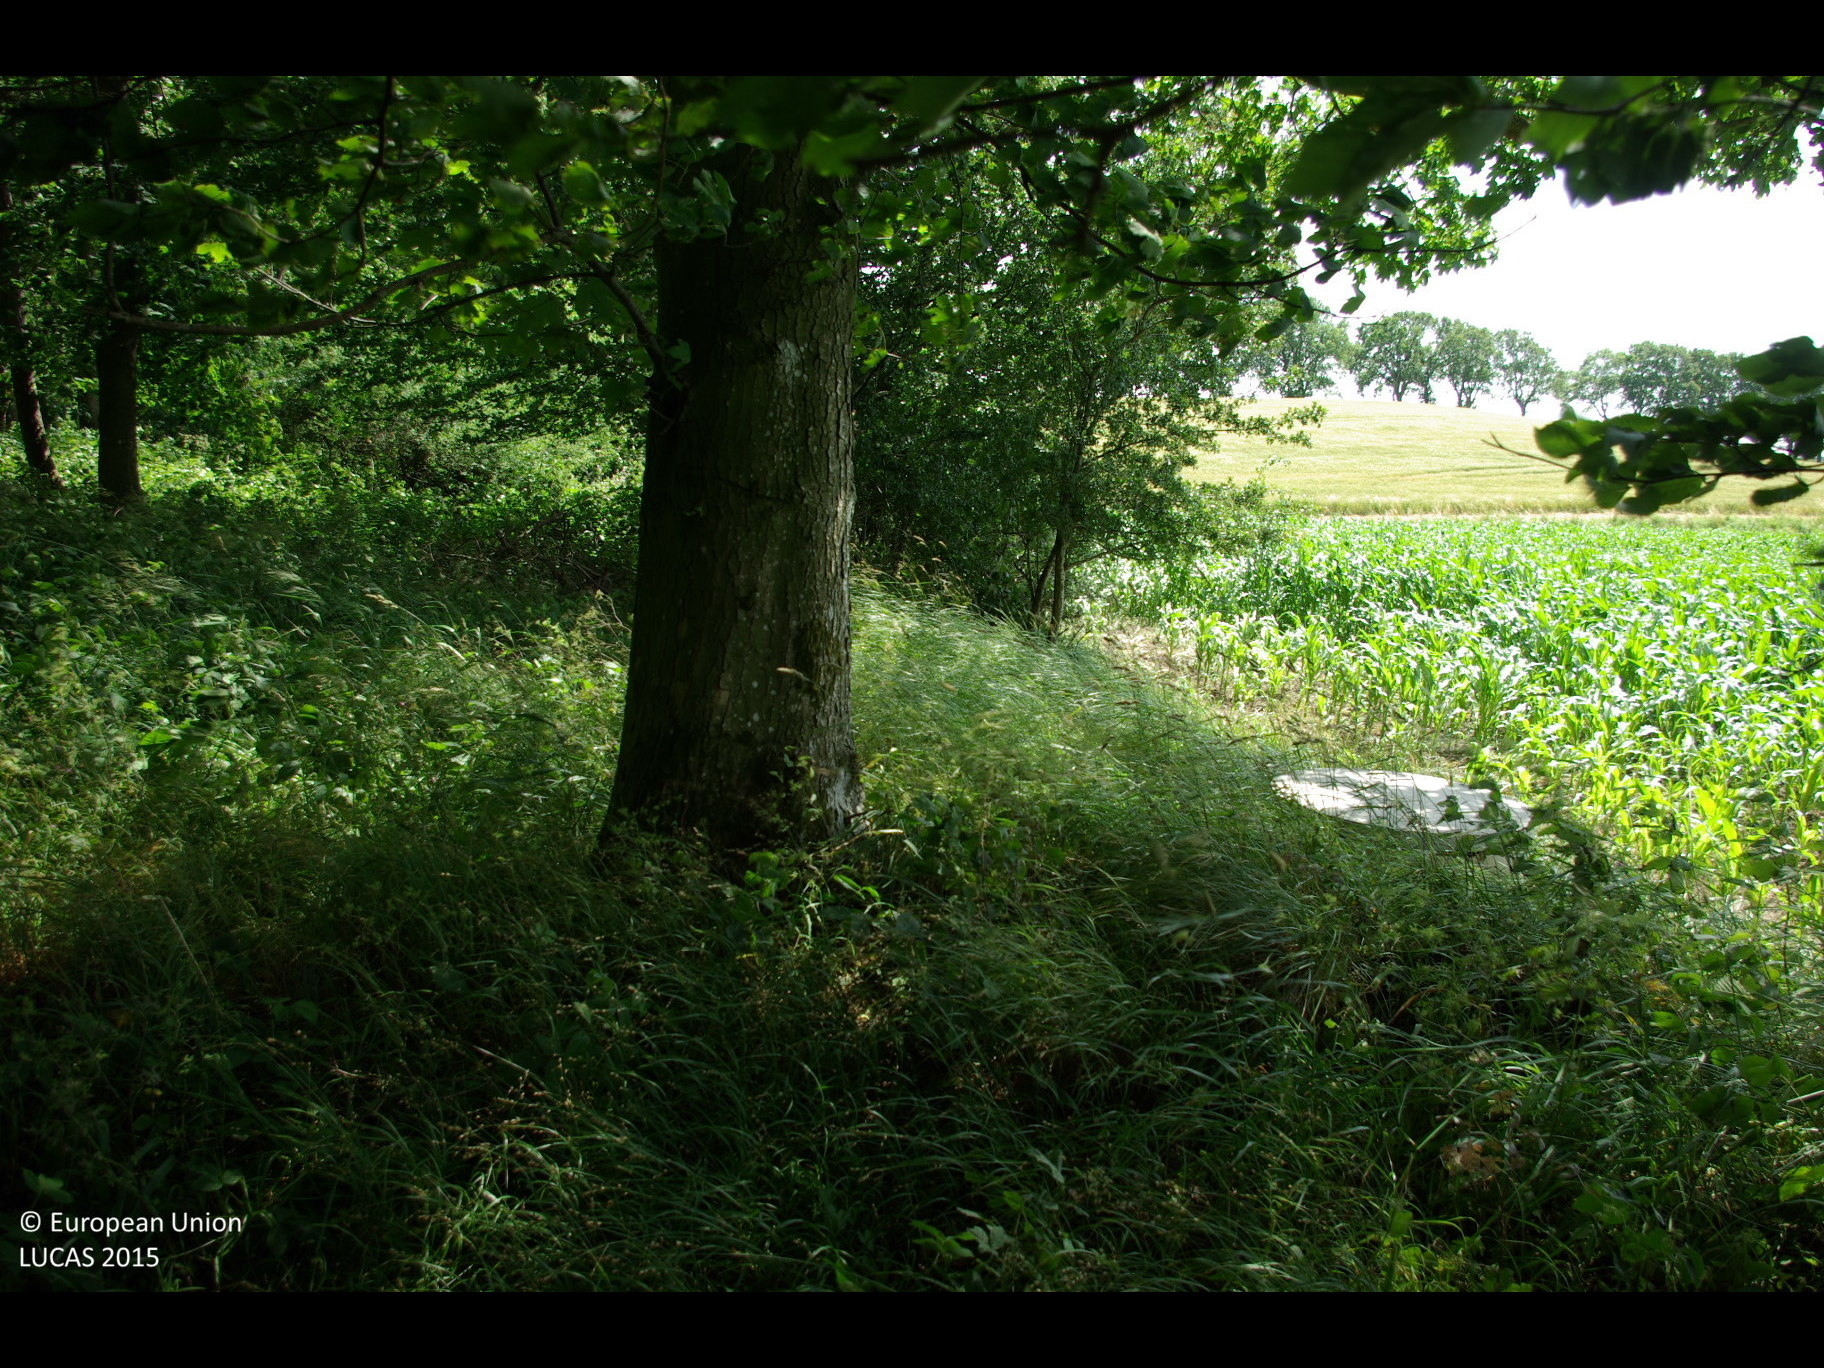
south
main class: Woodland
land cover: Other mixed woodland
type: hemiboreal forest and nemoral coniferous forest and mixed broadleaved-coniferous forest
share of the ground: > 75 %
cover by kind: coniferous forest trees 40 %, broadleaved forest trees 40 %, herbaceous plants 20 %
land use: Forestry
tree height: > 5 m
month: July
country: DE
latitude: 54.5701
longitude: 9.8918
